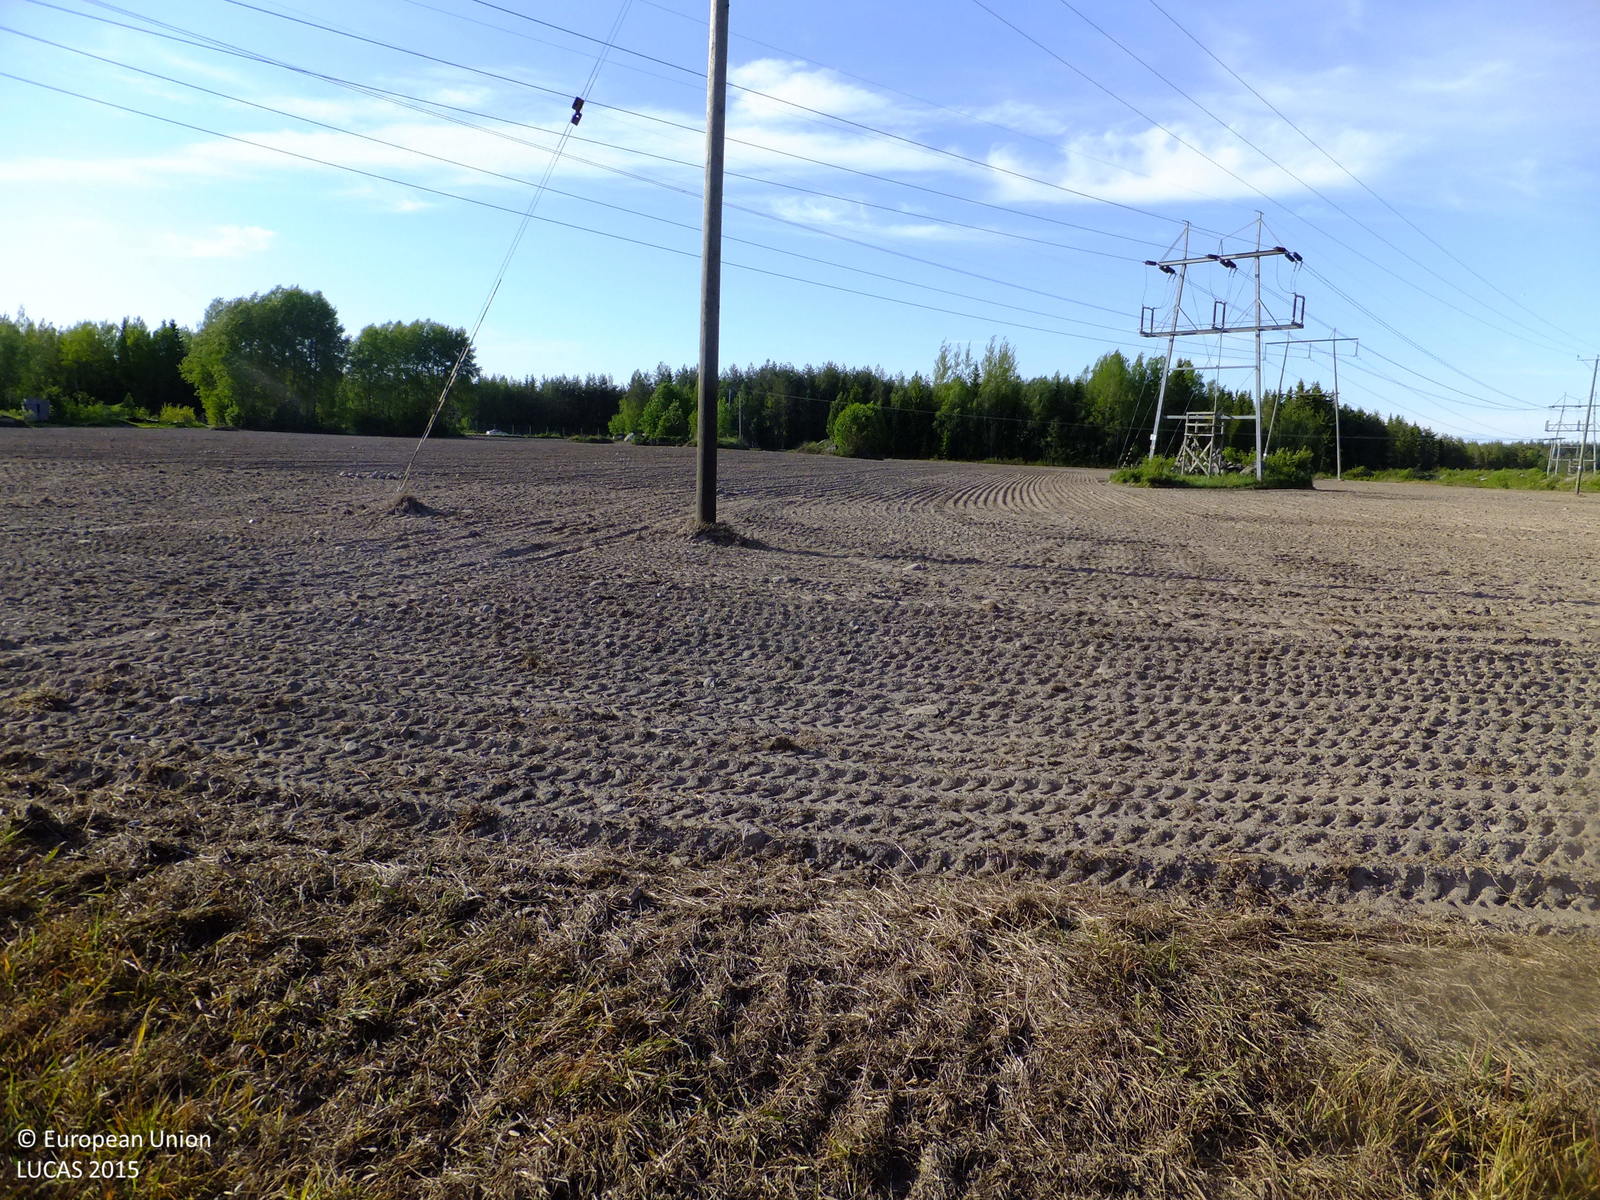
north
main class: Grassland
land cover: Grassland without tree/shrub cover
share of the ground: > 75 %
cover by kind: herbaceous plants 100 %
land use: Agriculture (excluding fallow land and kitchen gardens)
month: June
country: FI
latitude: 63.5050
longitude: 22.6464
